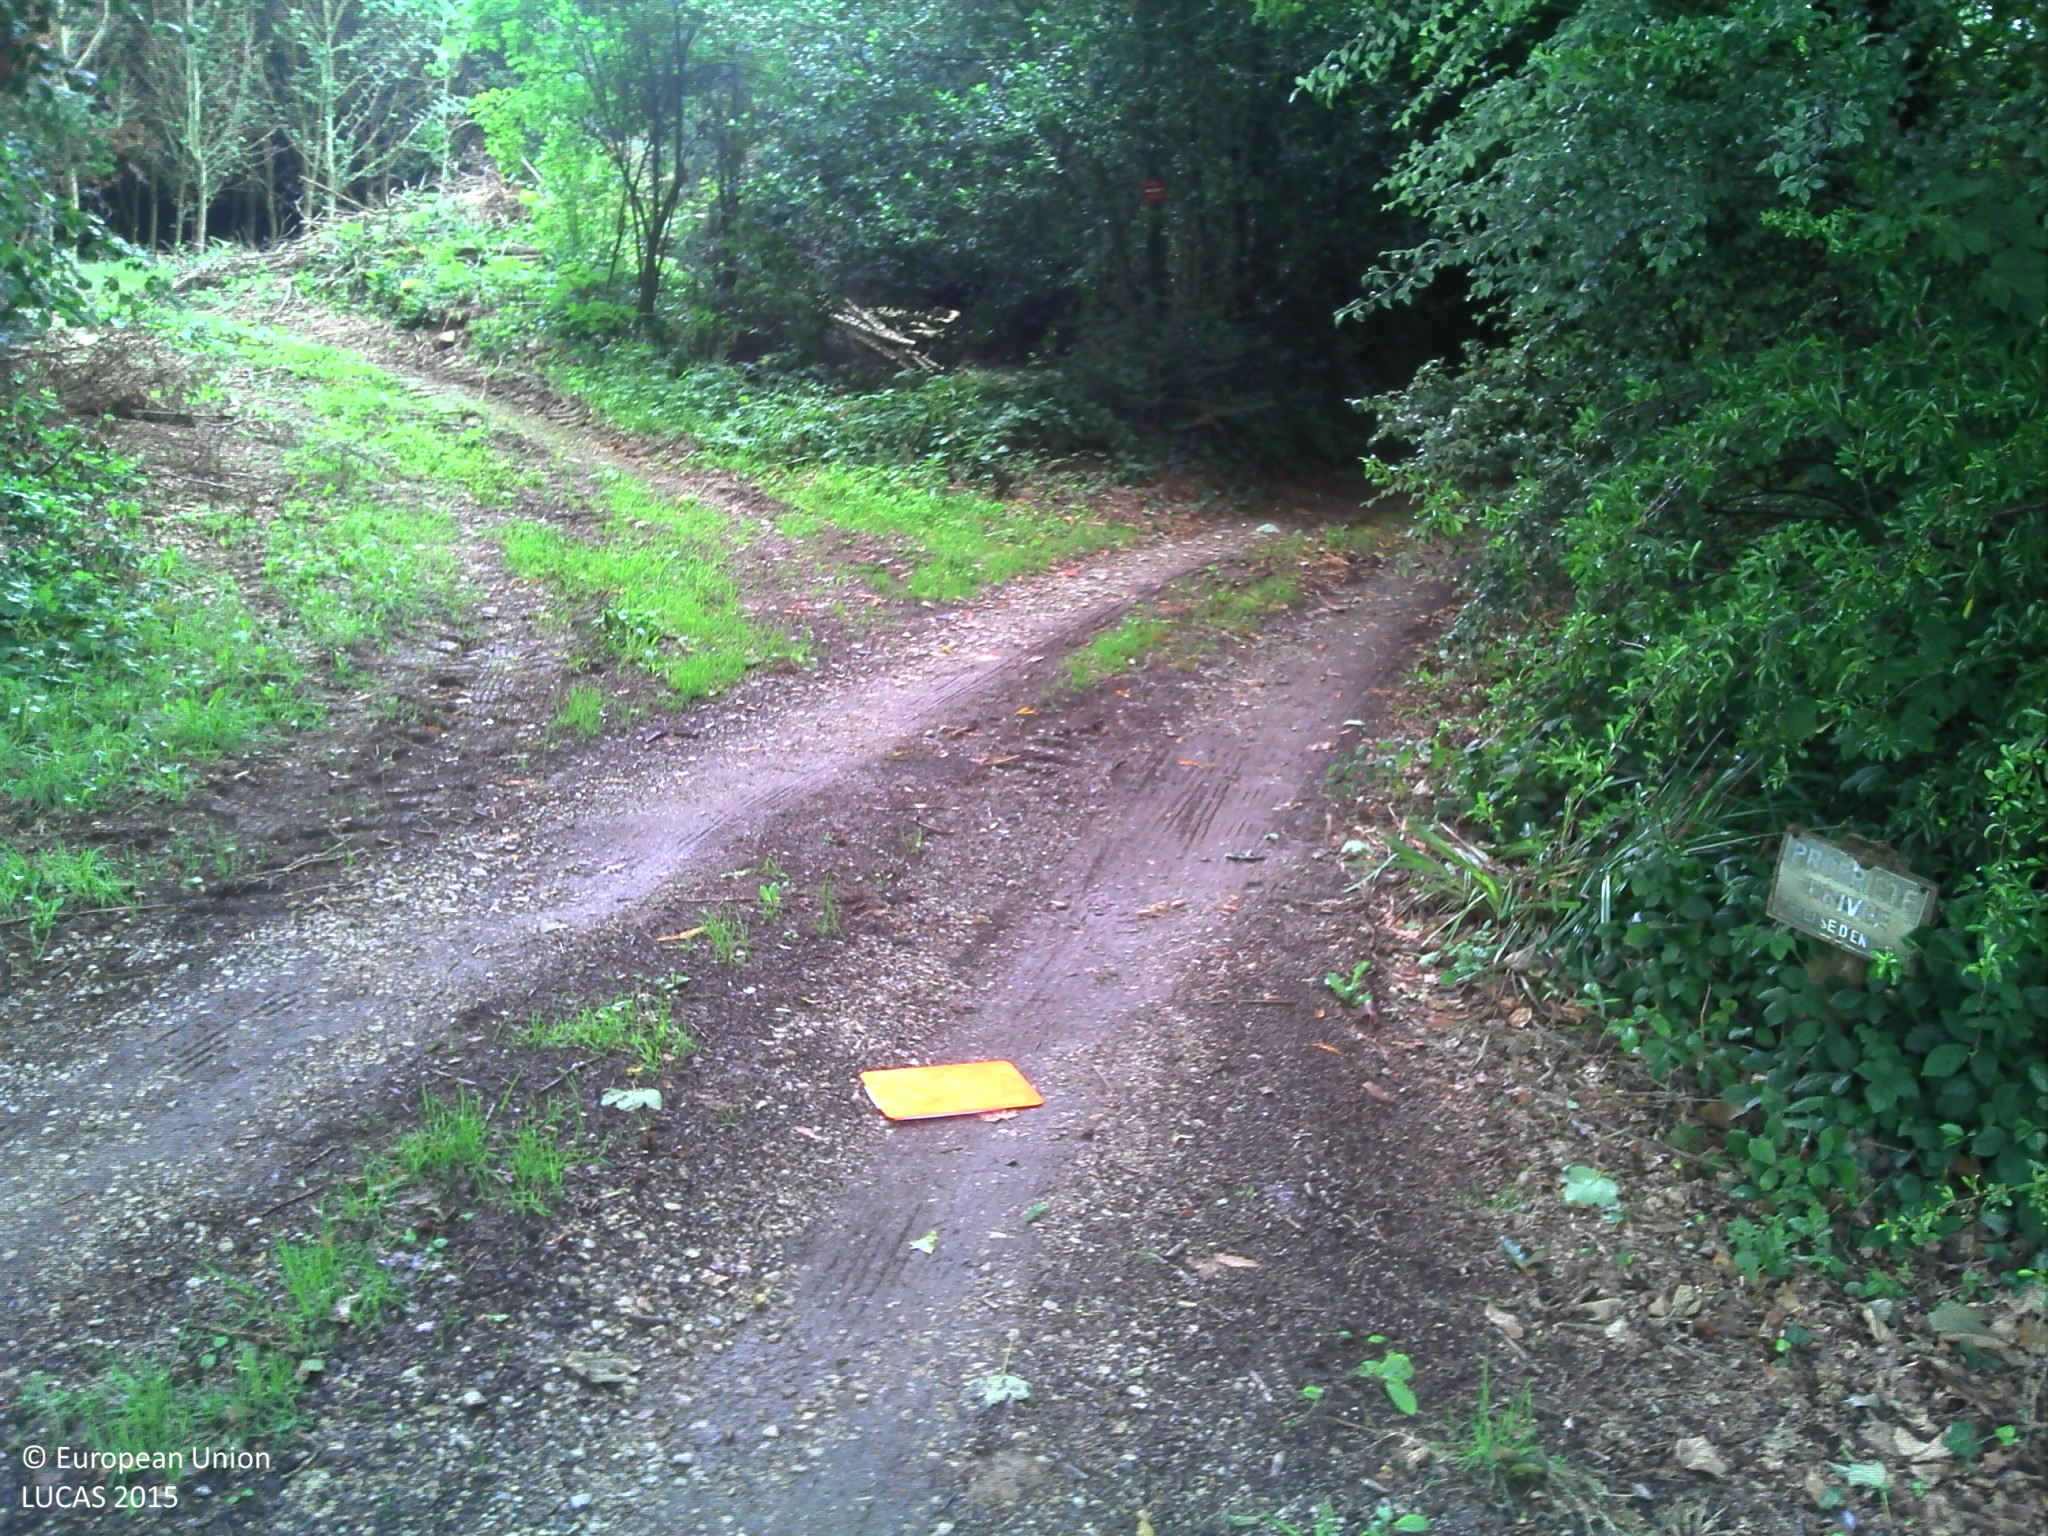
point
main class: Woodland
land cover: Broadleaved woodland
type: mesophytic deciduous forest
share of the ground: > 75 %
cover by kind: broadleaved forest trees 90 %, herbaceous plants 10 %
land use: Forestry
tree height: > 5 m
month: July
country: FR
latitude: 48.2199
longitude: -3.1133
